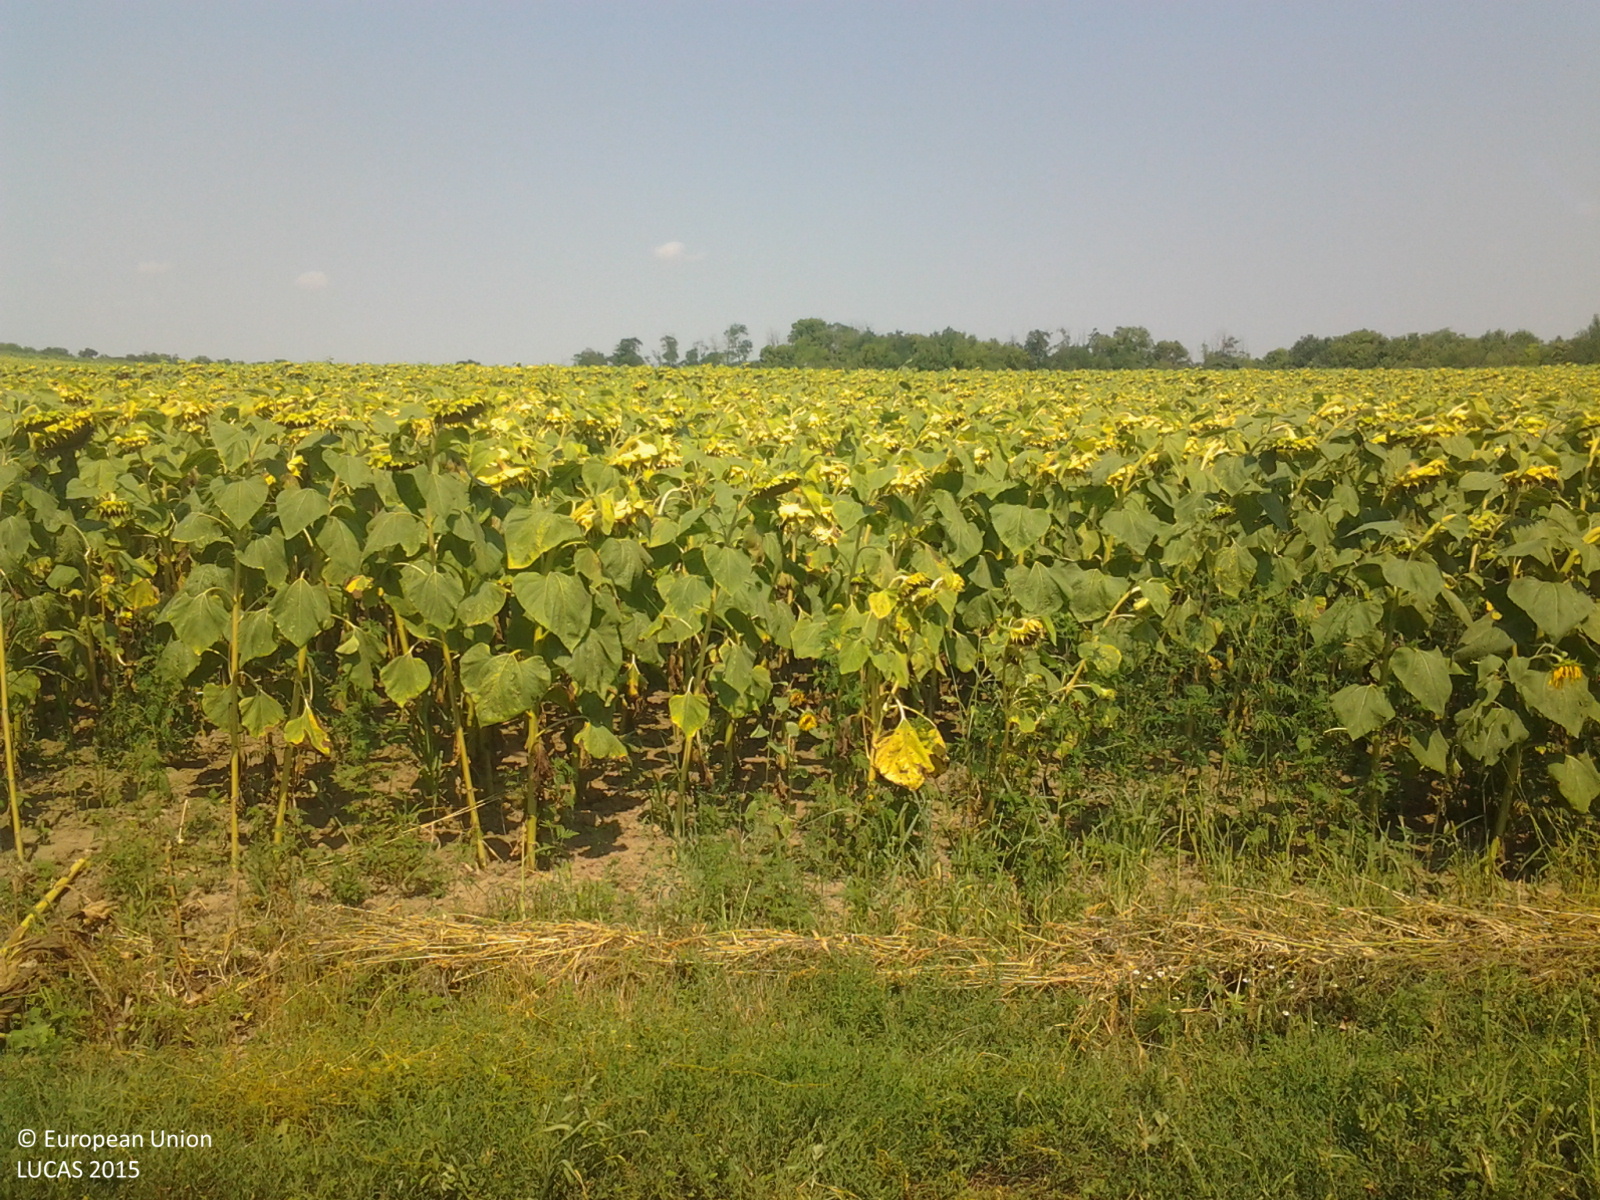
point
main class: Cropland
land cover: Sunflower
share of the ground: > 75 %
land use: Agriculture (excluding fallow land and kitchen gardens)
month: August
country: HU
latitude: 46.6371
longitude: 18.3835
